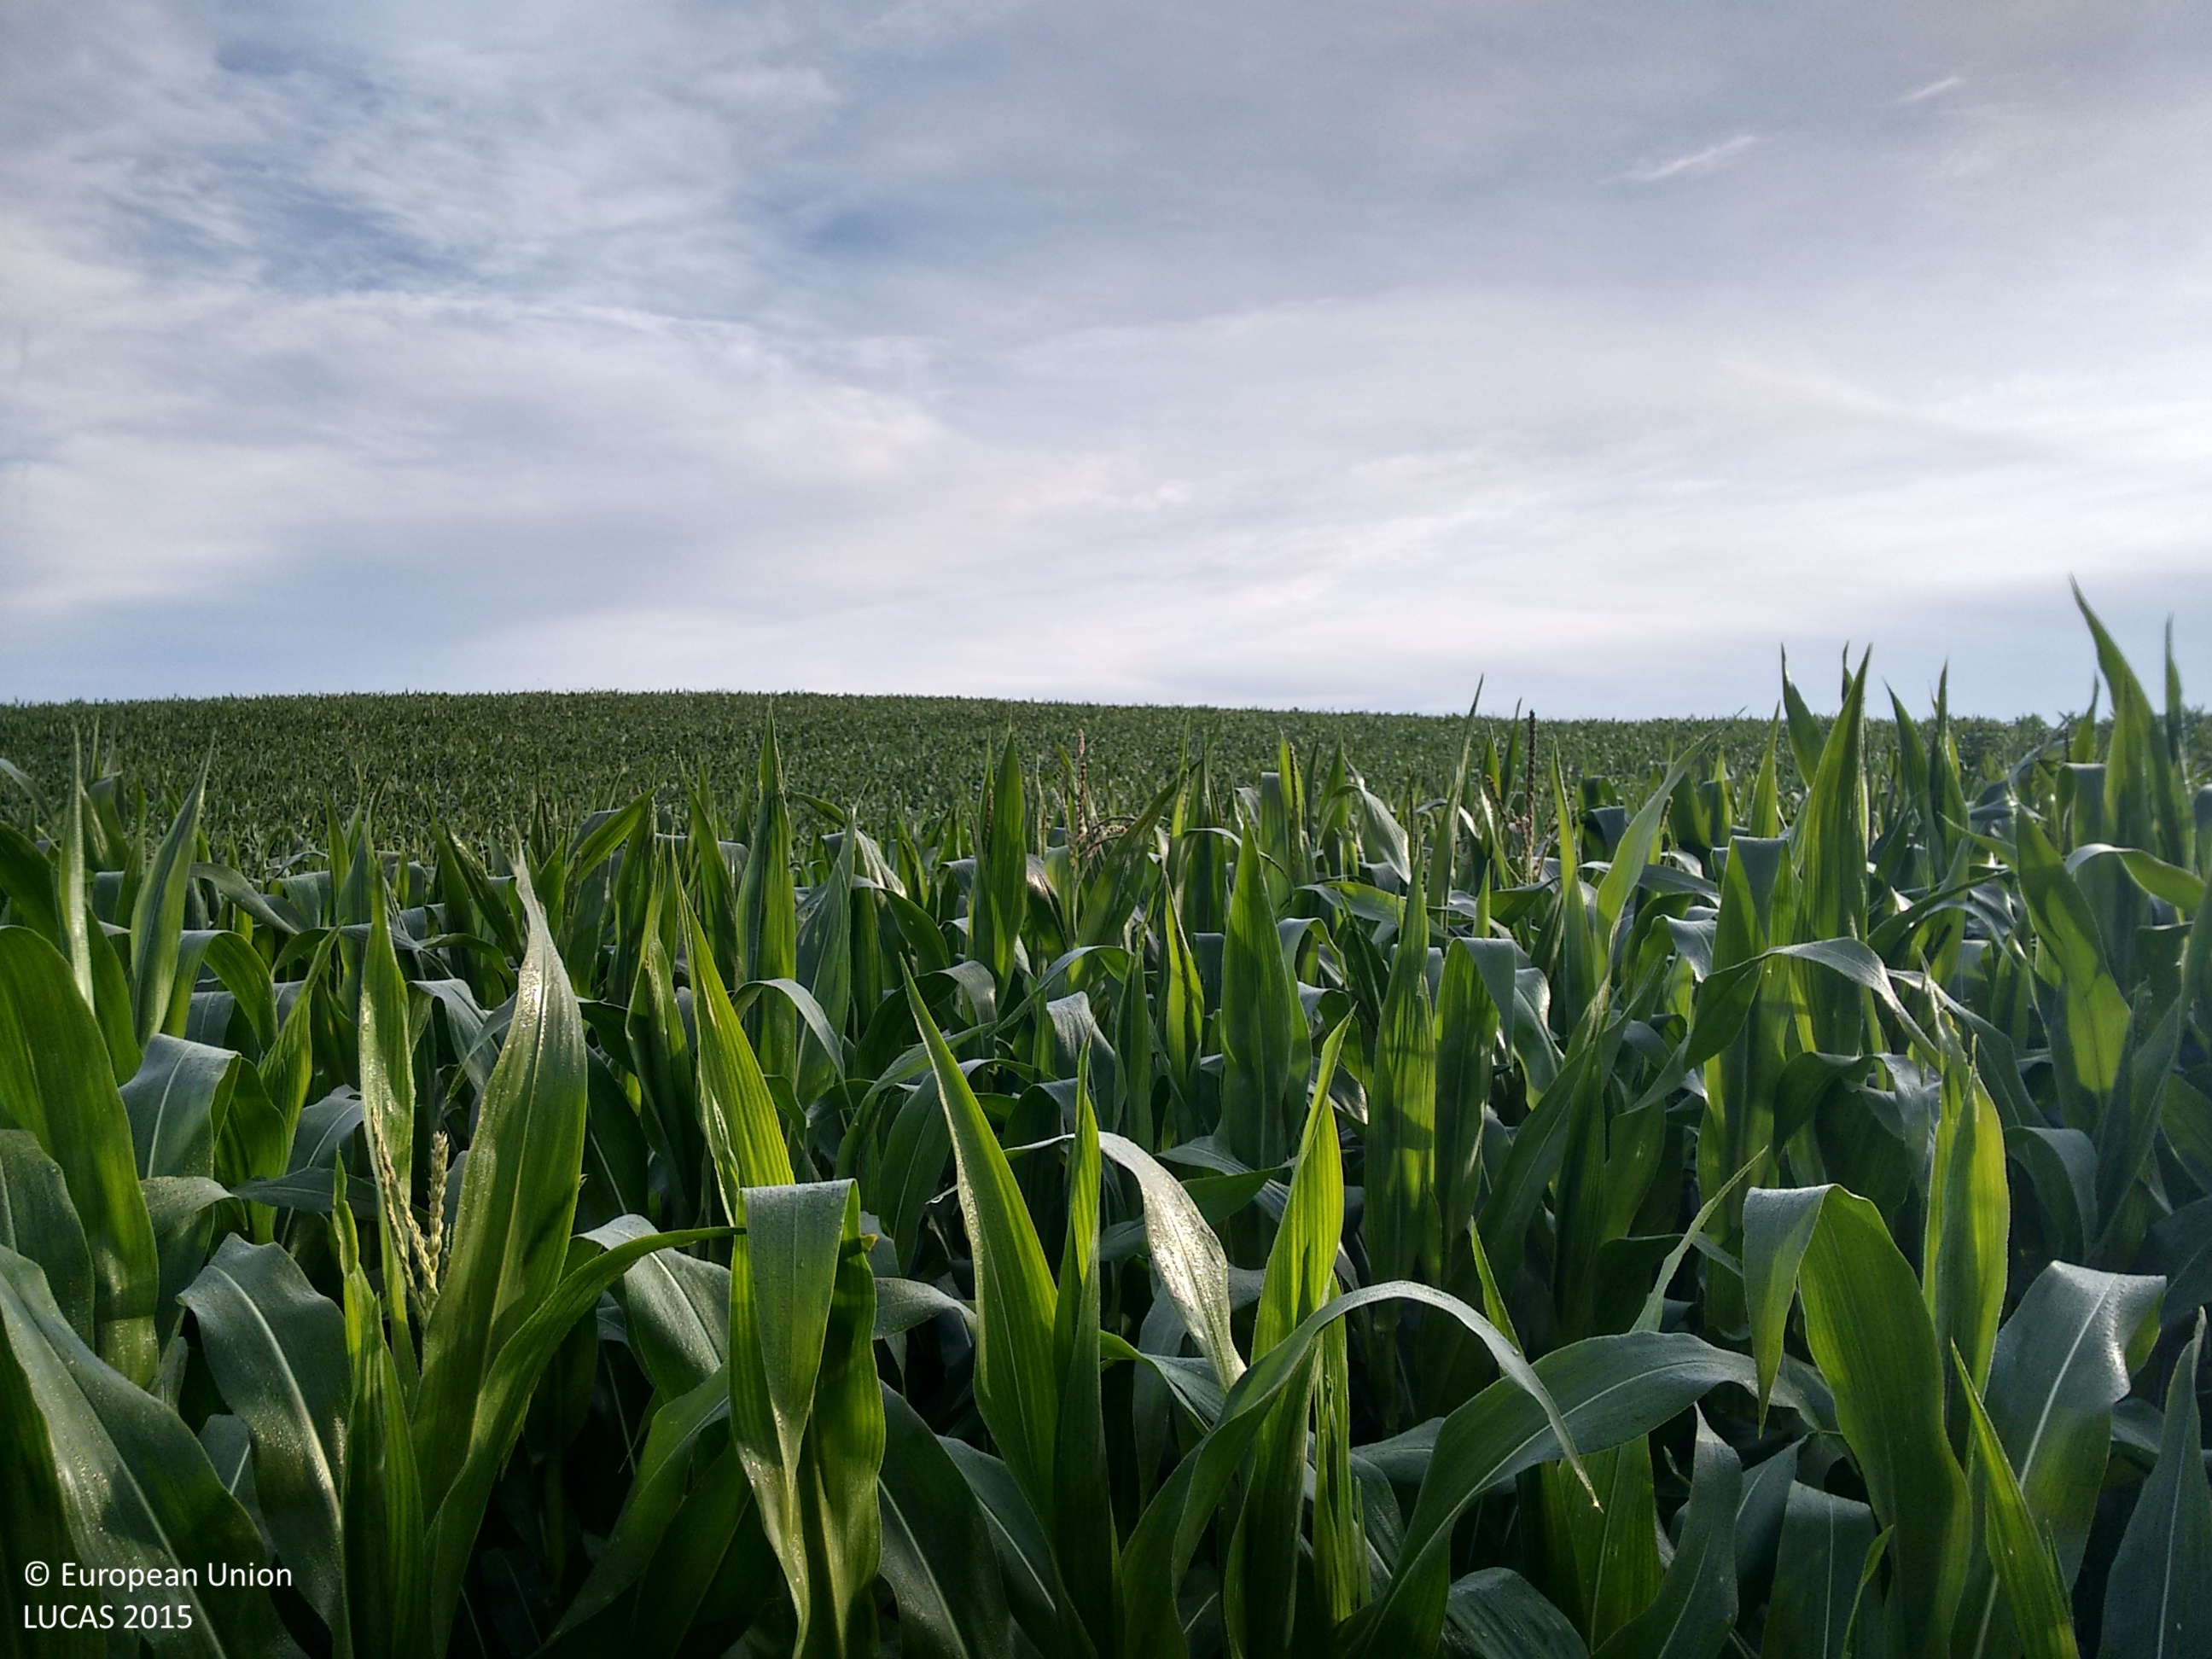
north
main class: Cropland
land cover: Maize
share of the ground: > 75 %
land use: Agriculture (excluding fallow land and kitchen gardens)
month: August
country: GB
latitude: 54.8283
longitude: -3.3566
